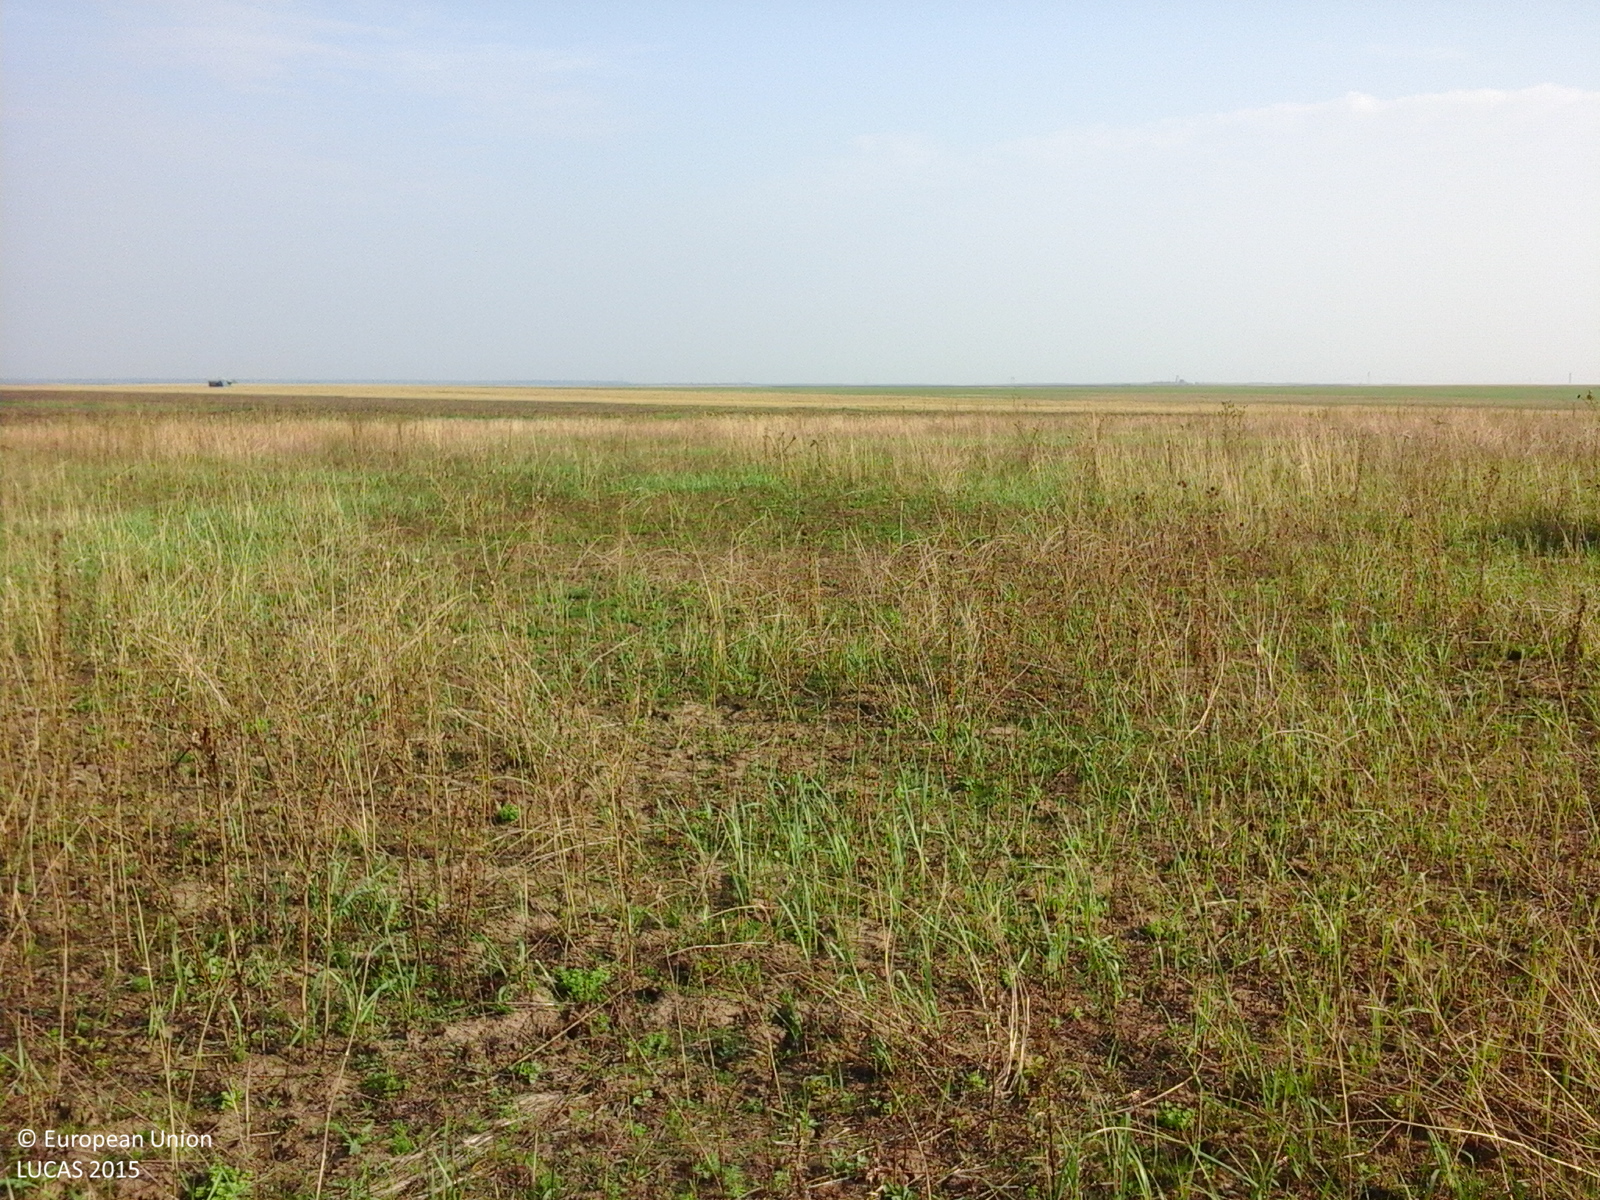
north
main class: Grassland
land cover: Grassland without tree/shrub cover
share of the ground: > 75 %
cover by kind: herbaceous plants 100 %
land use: Agriculture (excluding fallow land and kitchen gardens)
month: August
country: RO
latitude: 46.0616
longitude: 21.4492
